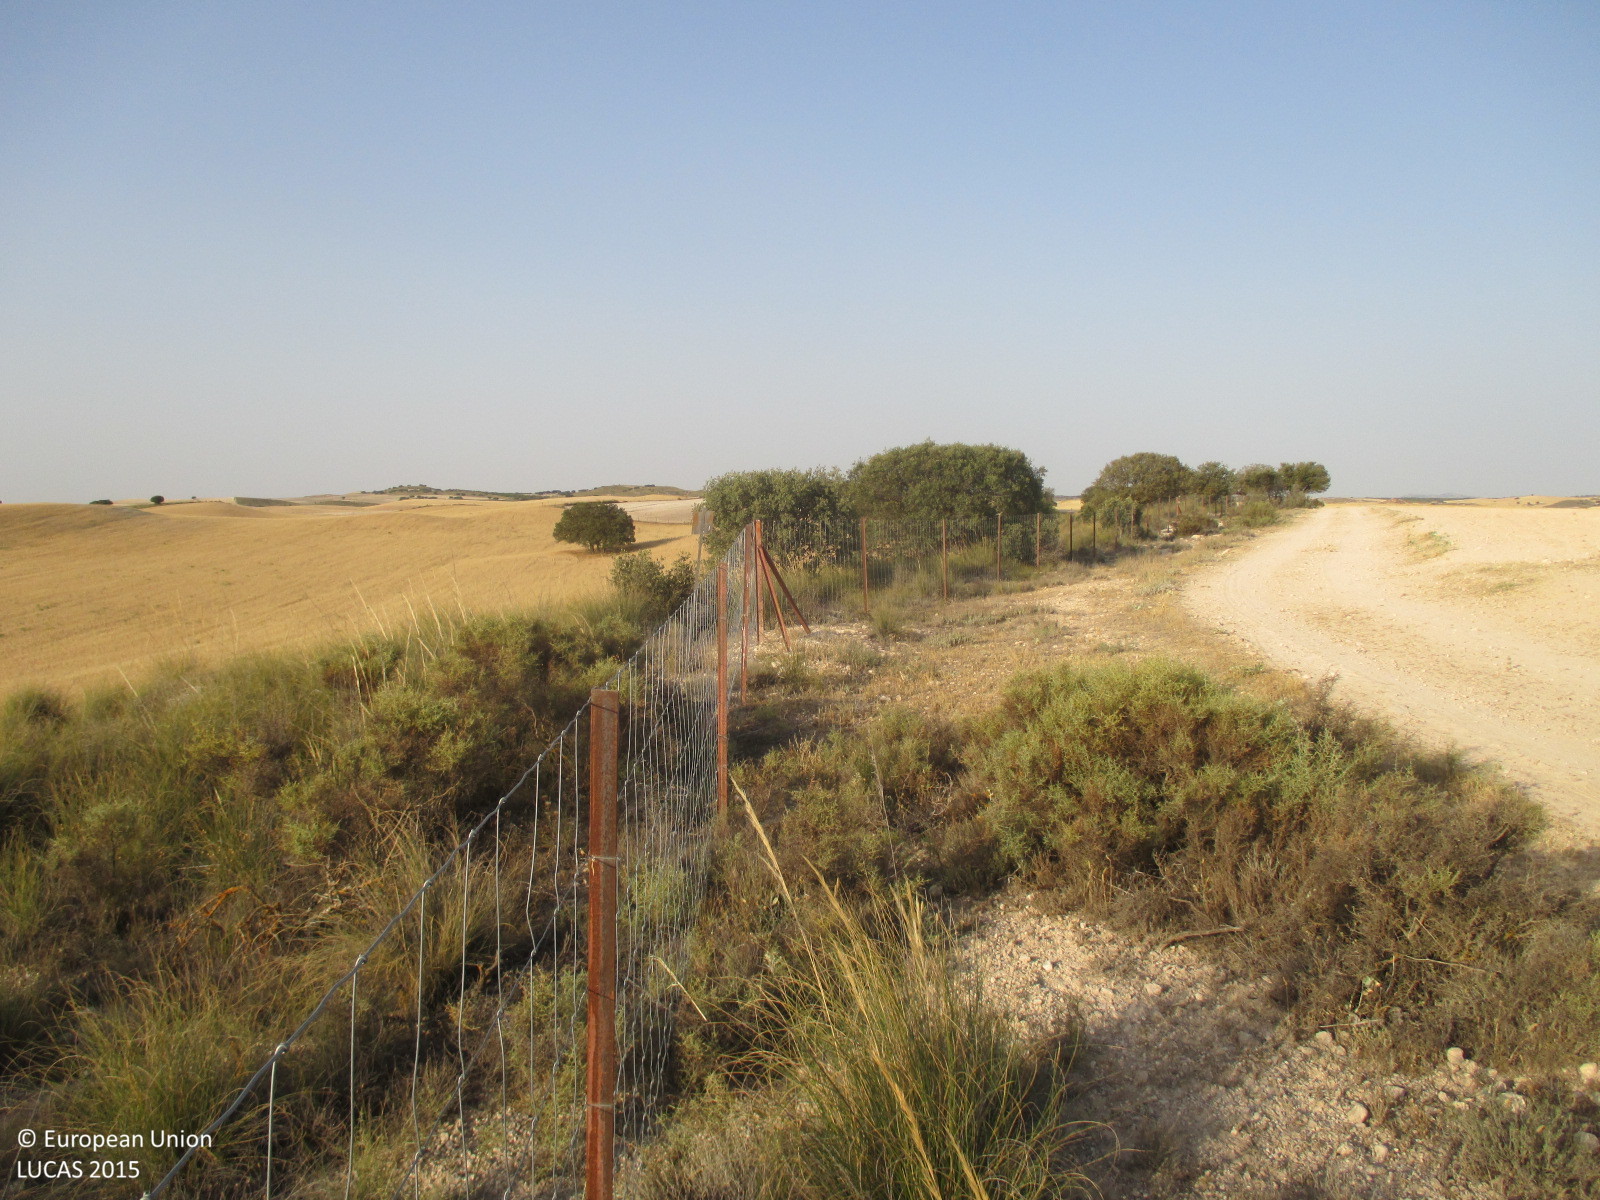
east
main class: Cropland
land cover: Oats
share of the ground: 25 - 50 %
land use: Agriculture (excluding fallow land and kitchen gardens)
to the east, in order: Oats; Broadleaved woodland; Fences; Barley; Grass margins; Tracks; Grass margins; Barley
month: June
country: ES
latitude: 37.7728
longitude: -2.4200
